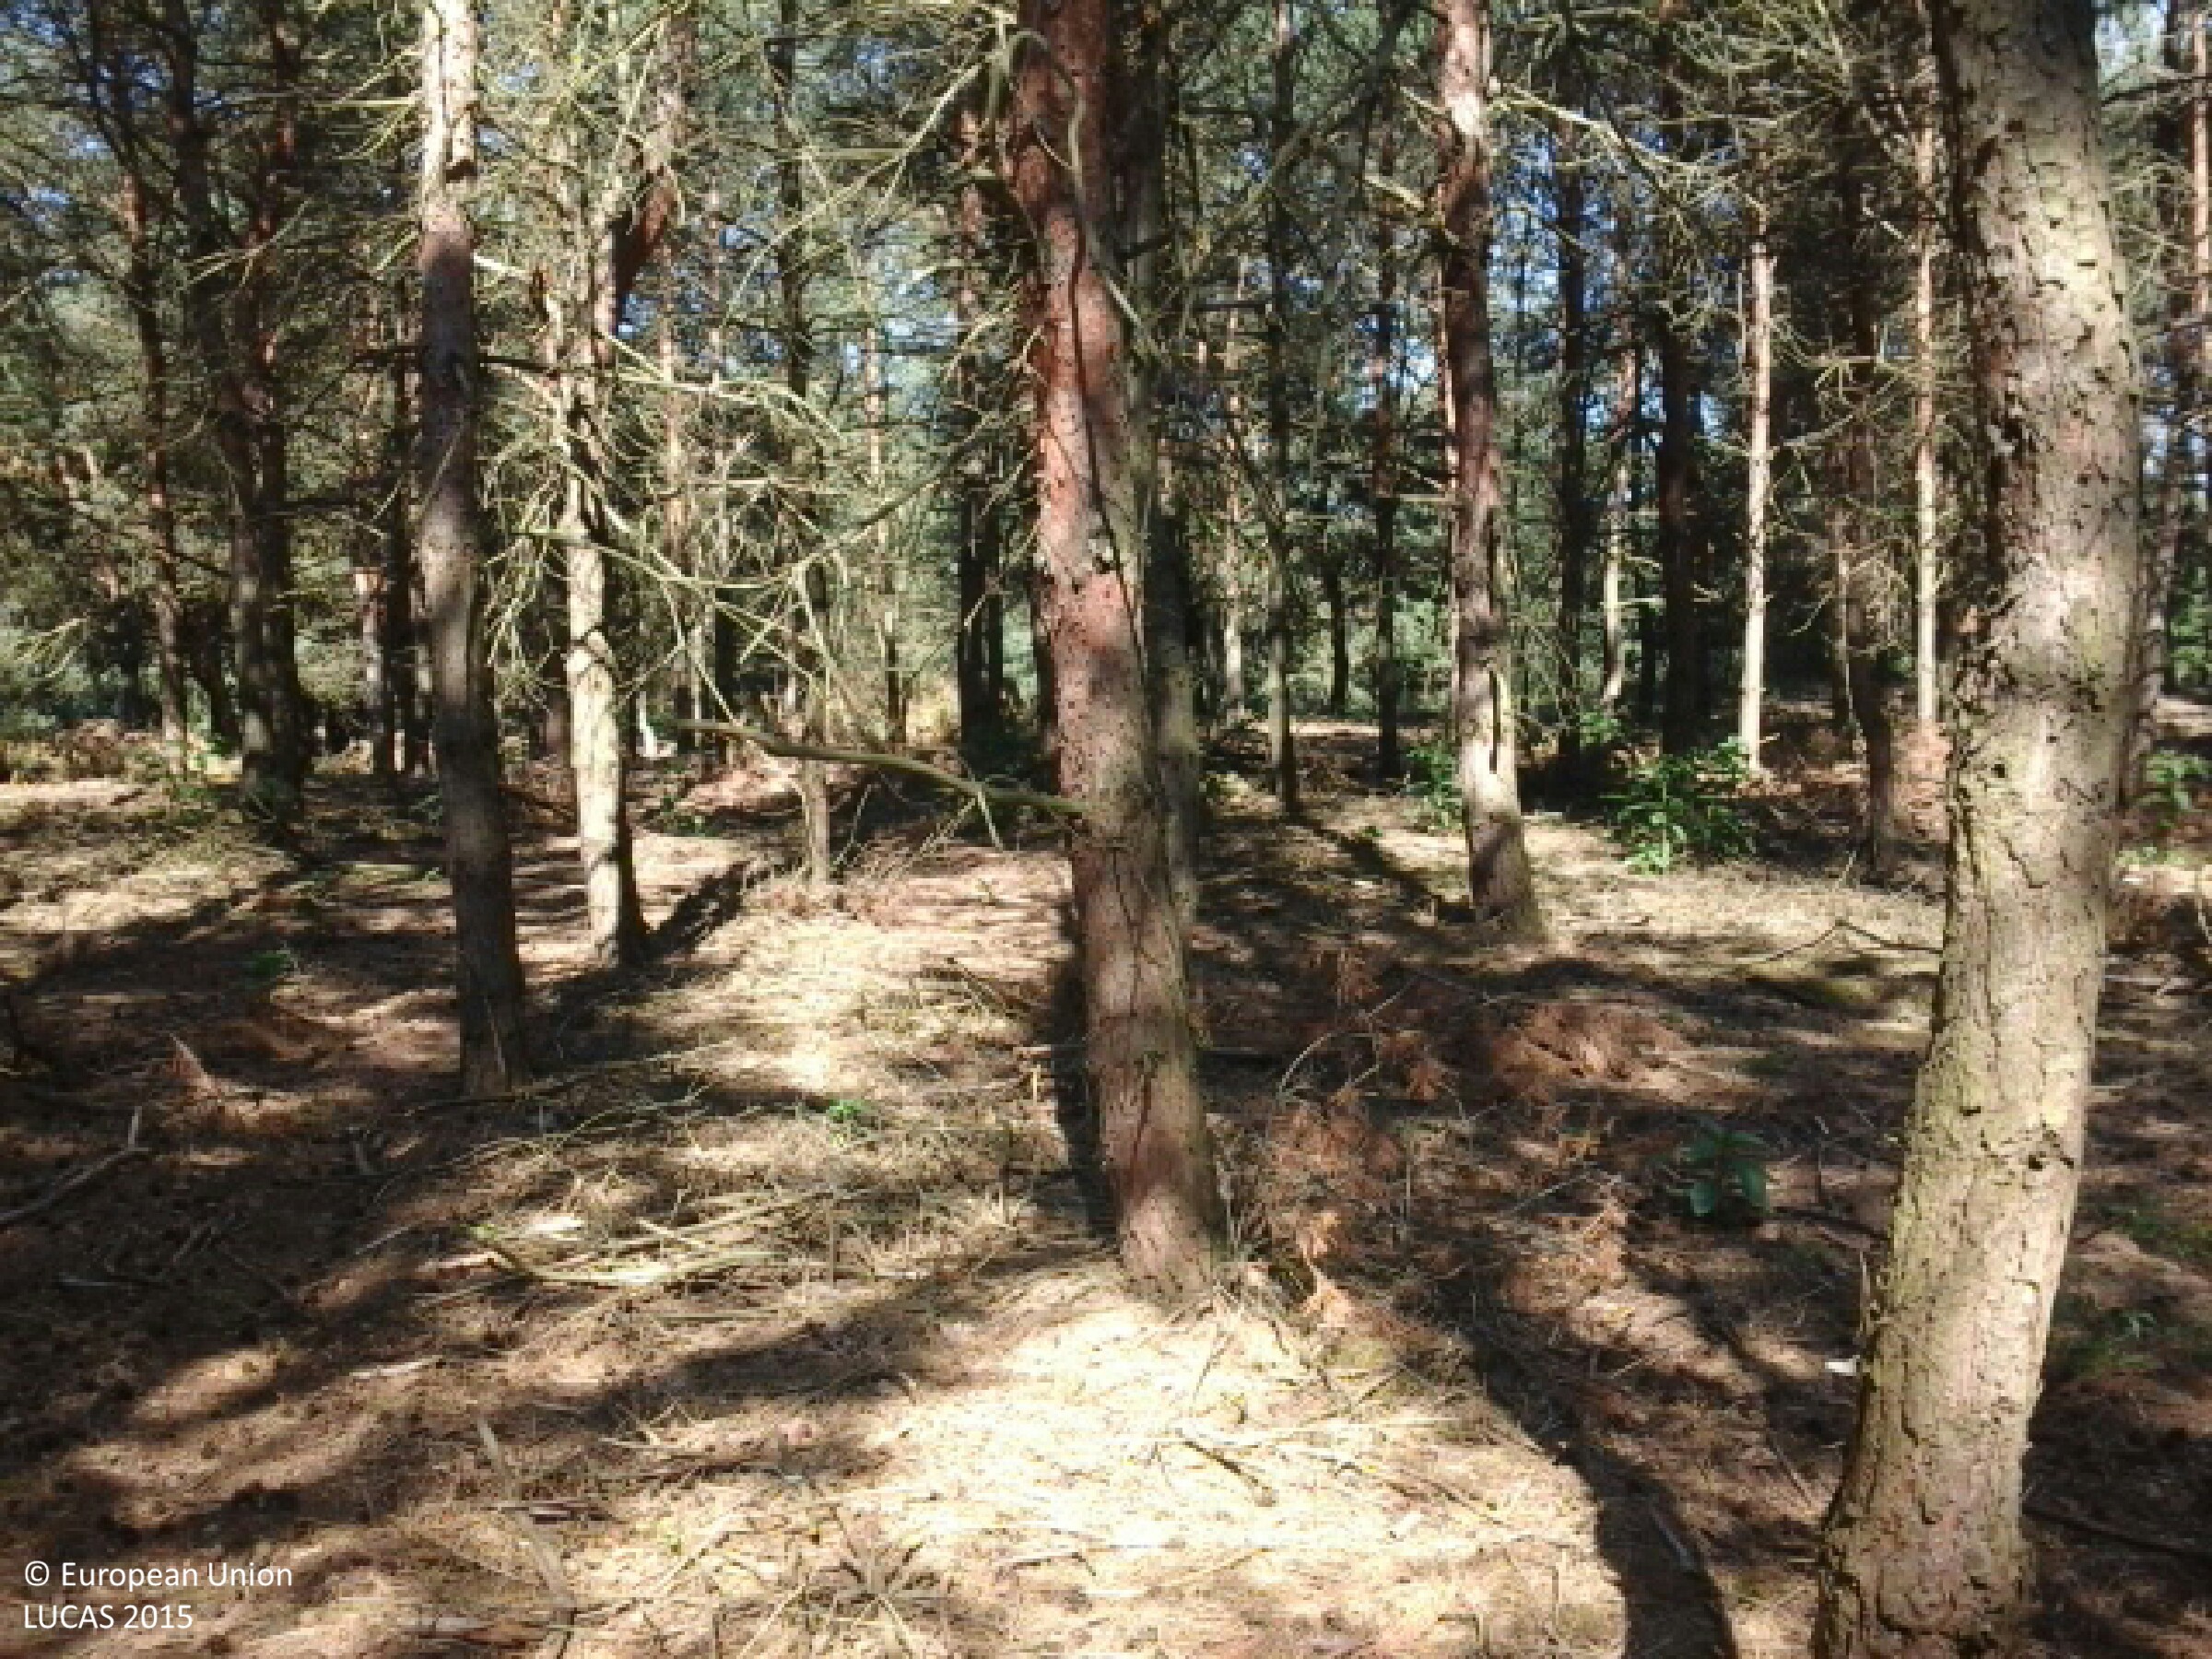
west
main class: Woodland
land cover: Pine dominated coniferous woodland
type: hemiboreal forest and nemoral coniferous forest and mixed broadleaved-coniferous forest
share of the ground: > 75 %
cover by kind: coniferous forest trees 85 %, consolidated bare surface 10 %, shrubs 5 %
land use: Forestry
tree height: > 5 m
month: July
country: HU
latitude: 47.9613
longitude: 22.2019
